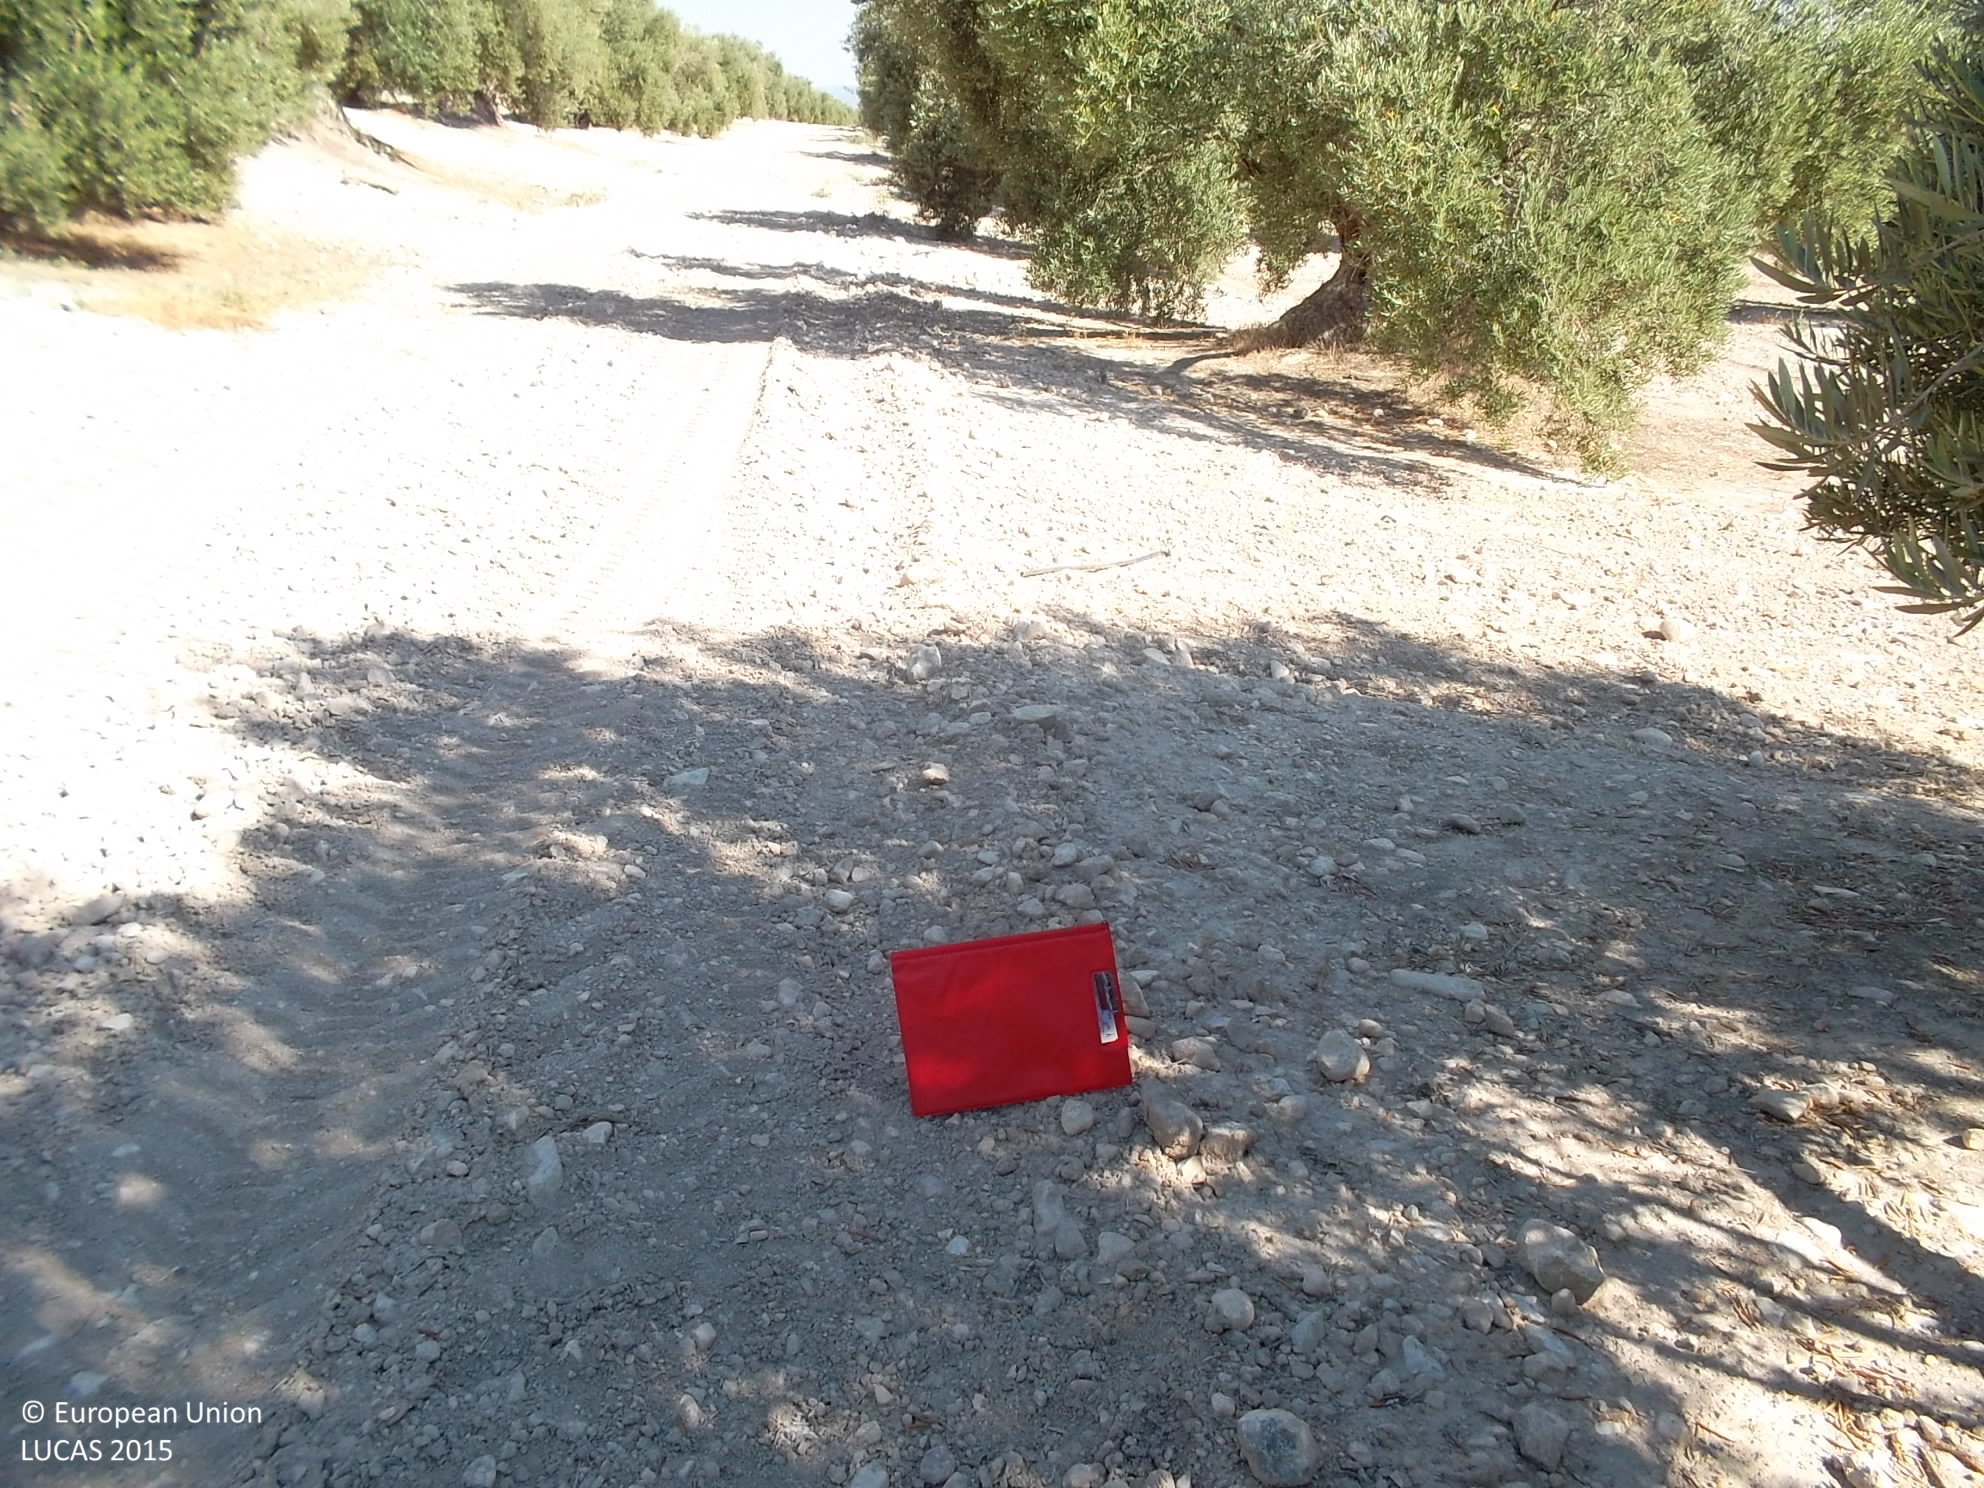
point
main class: Cropland
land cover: Olive groves
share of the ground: 25 - 50 %
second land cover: Other bare soil
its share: > 75 %
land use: Agriculture (excluding fallow land and kitchen gardens)
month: June
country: ES
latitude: 37.8864
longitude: -3.3353
